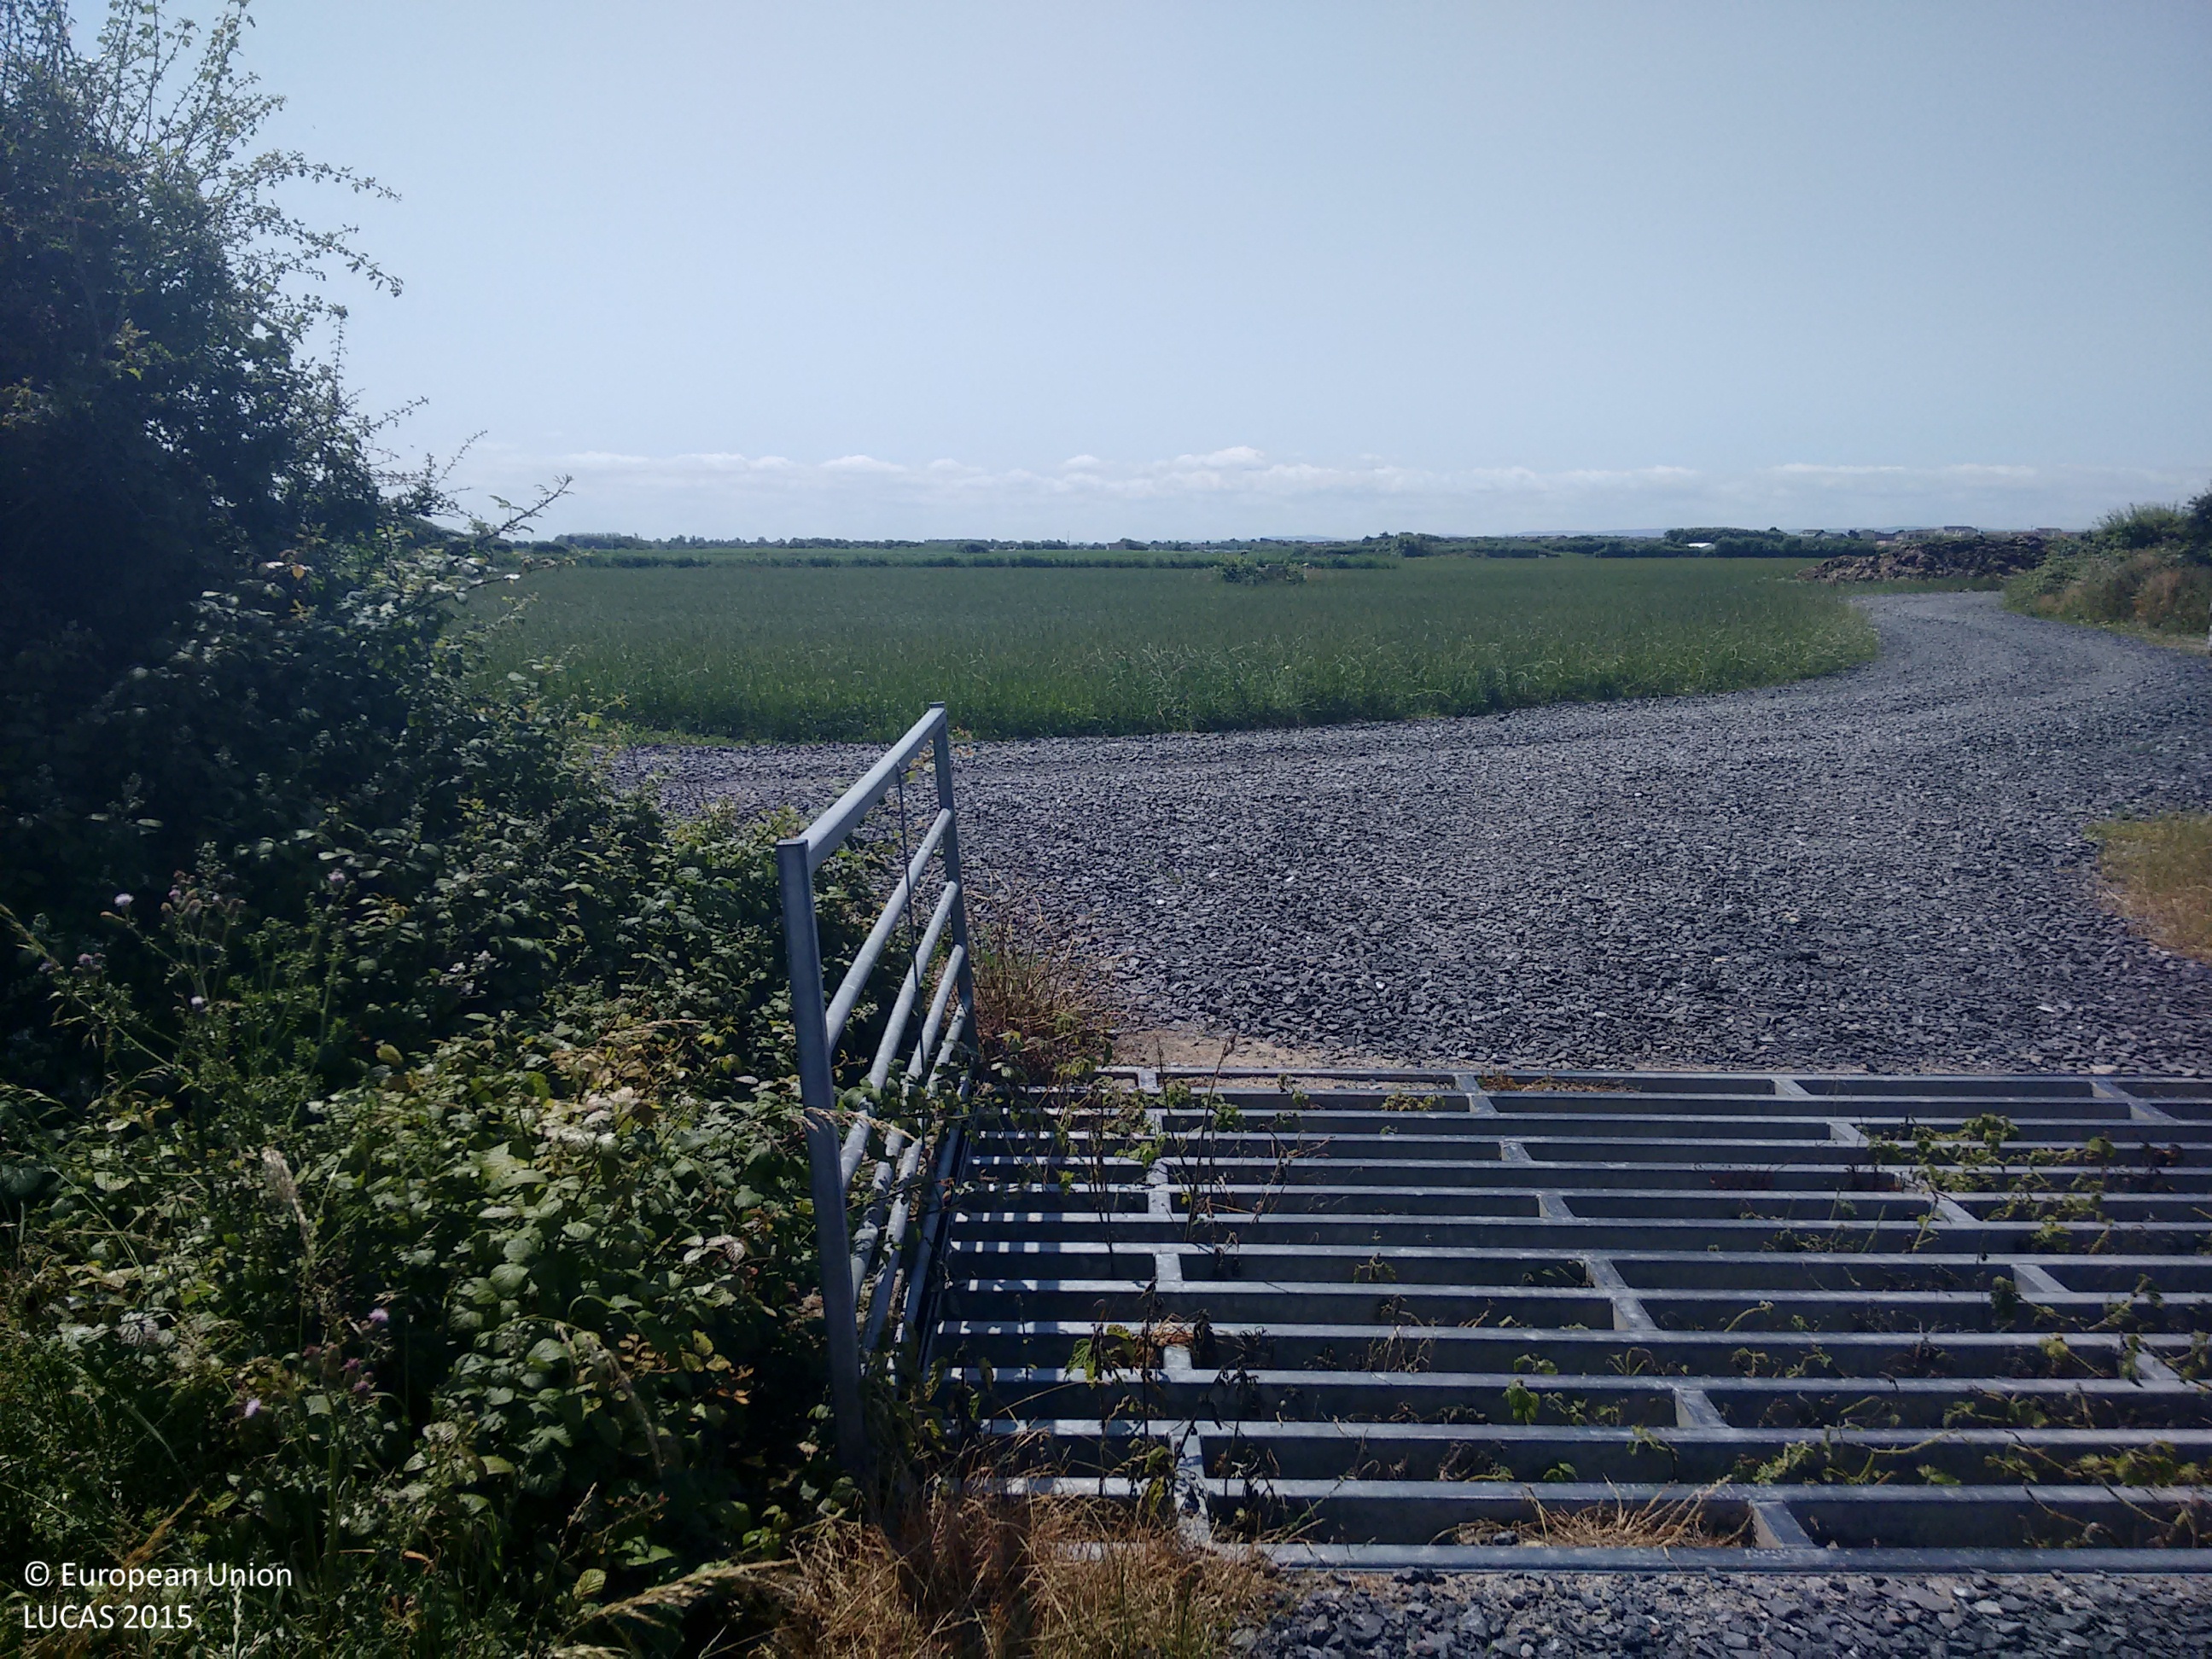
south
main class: Cropland
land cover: Common wheat
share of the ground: > 75 %
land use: Agriculture (excluding fallow land and kitchen gardens)
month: July
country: GB
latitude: 51.3124
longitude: -3.0013
